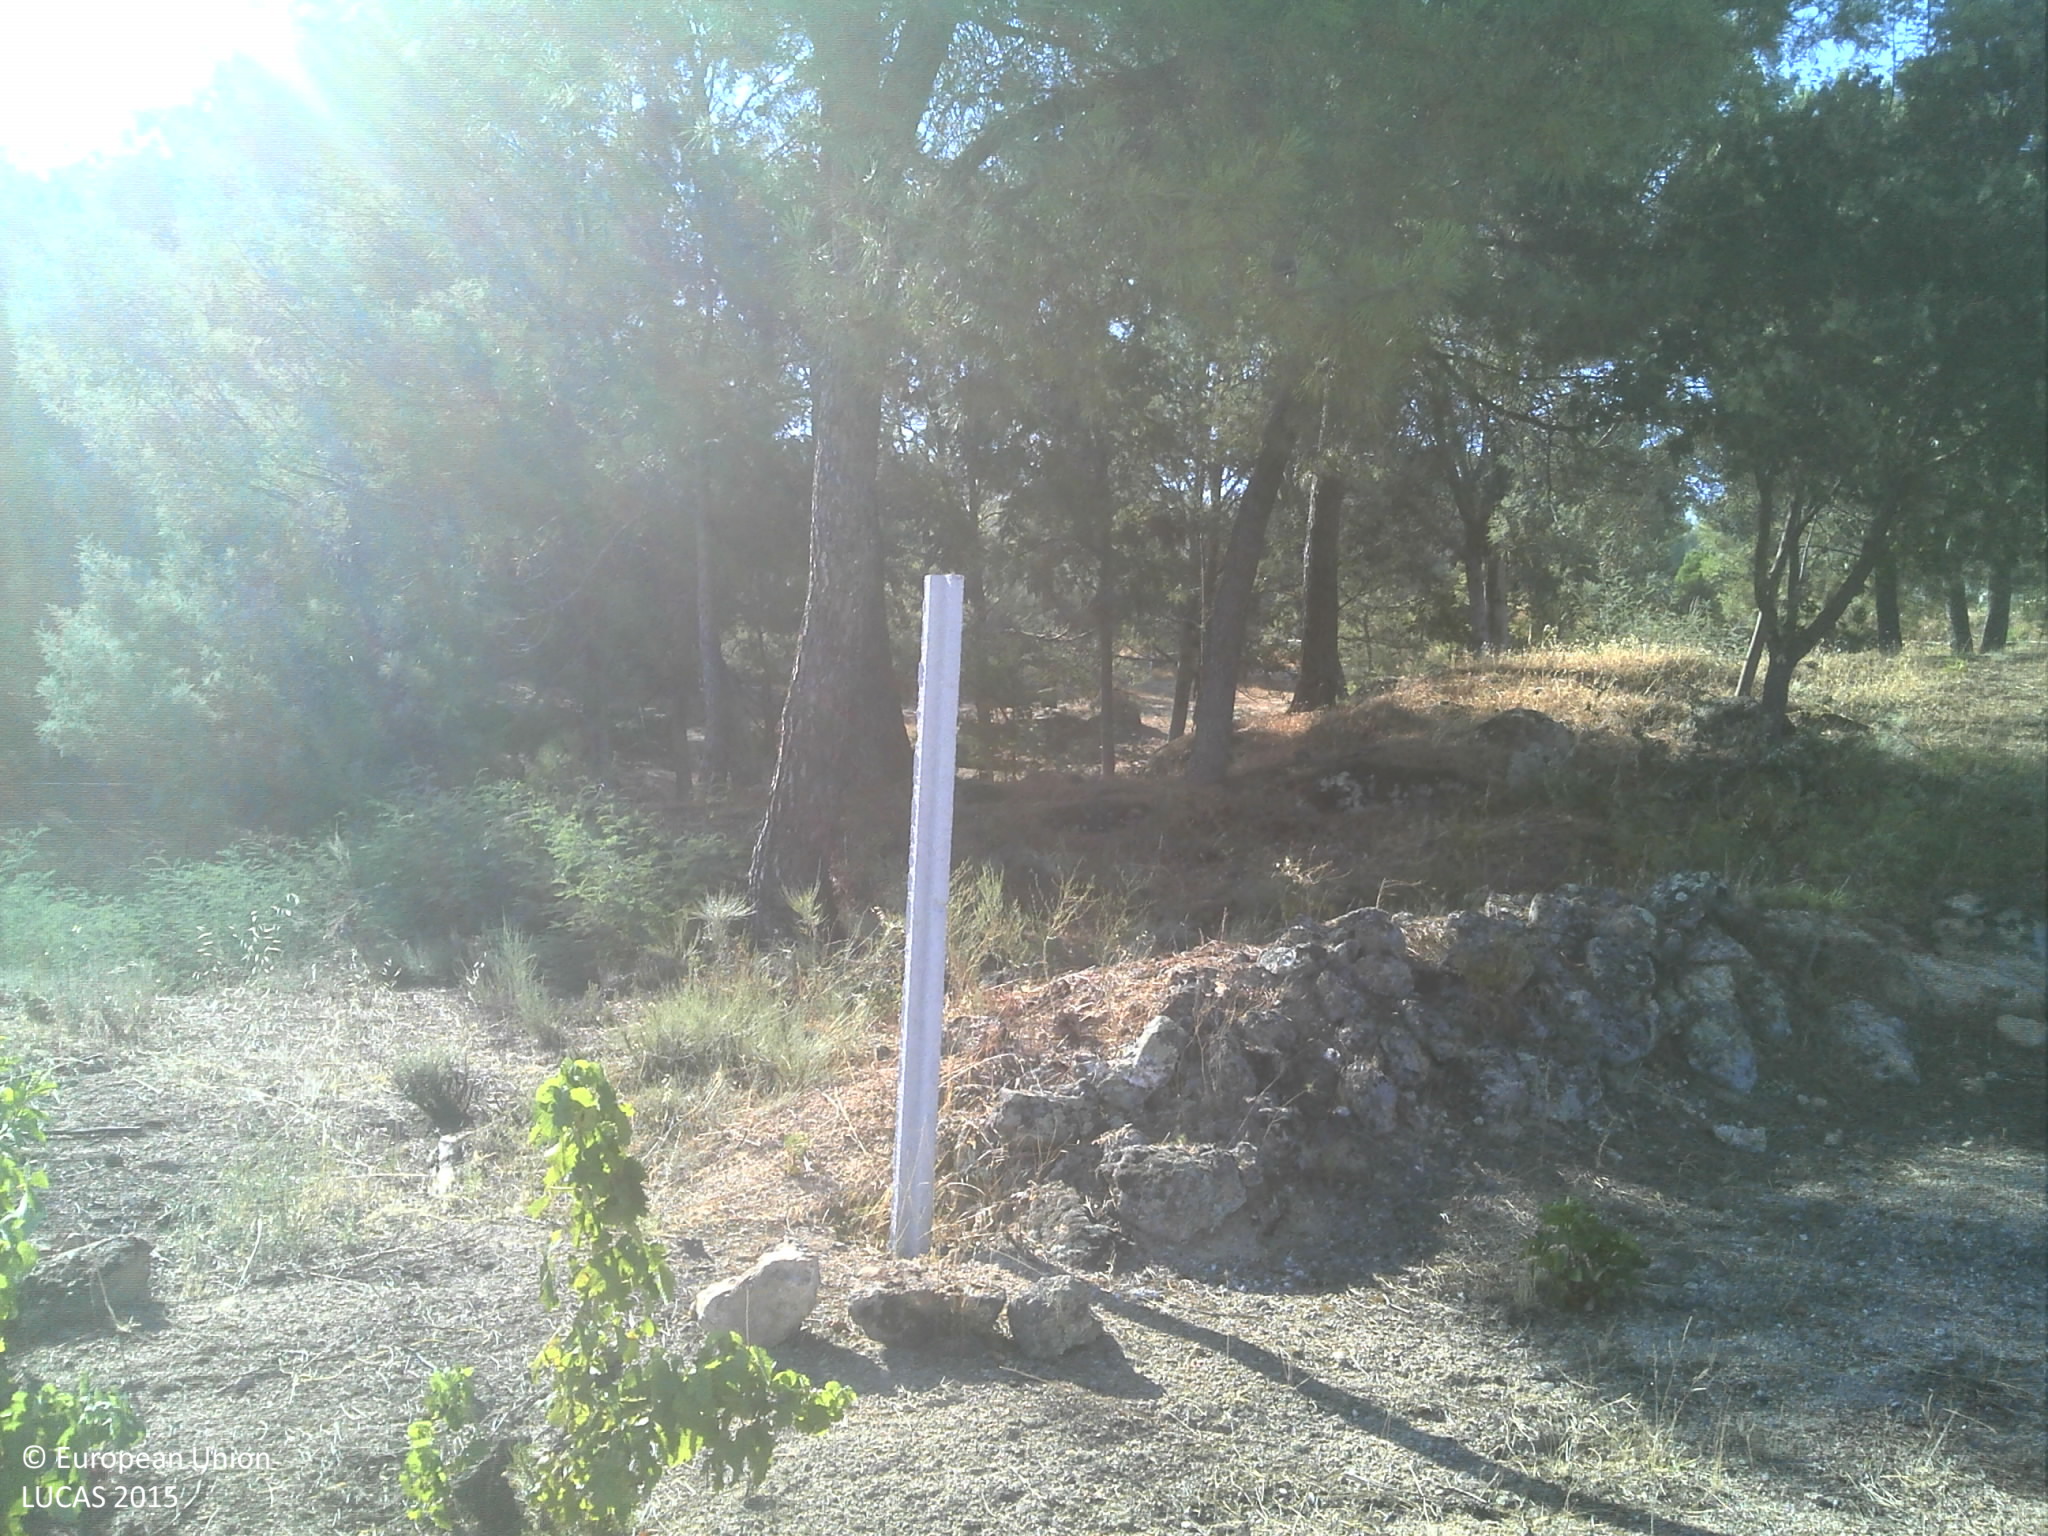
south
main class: Cropland
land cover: Vineyards
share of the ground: 10 - 25 %
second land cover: Spontaneously vegetated surfaces
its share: 10 - 25 %
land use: Agriculture (excluding fallow land and kitchen gardens)
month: July
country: PT
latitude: 40.2981
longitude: -7.4351
